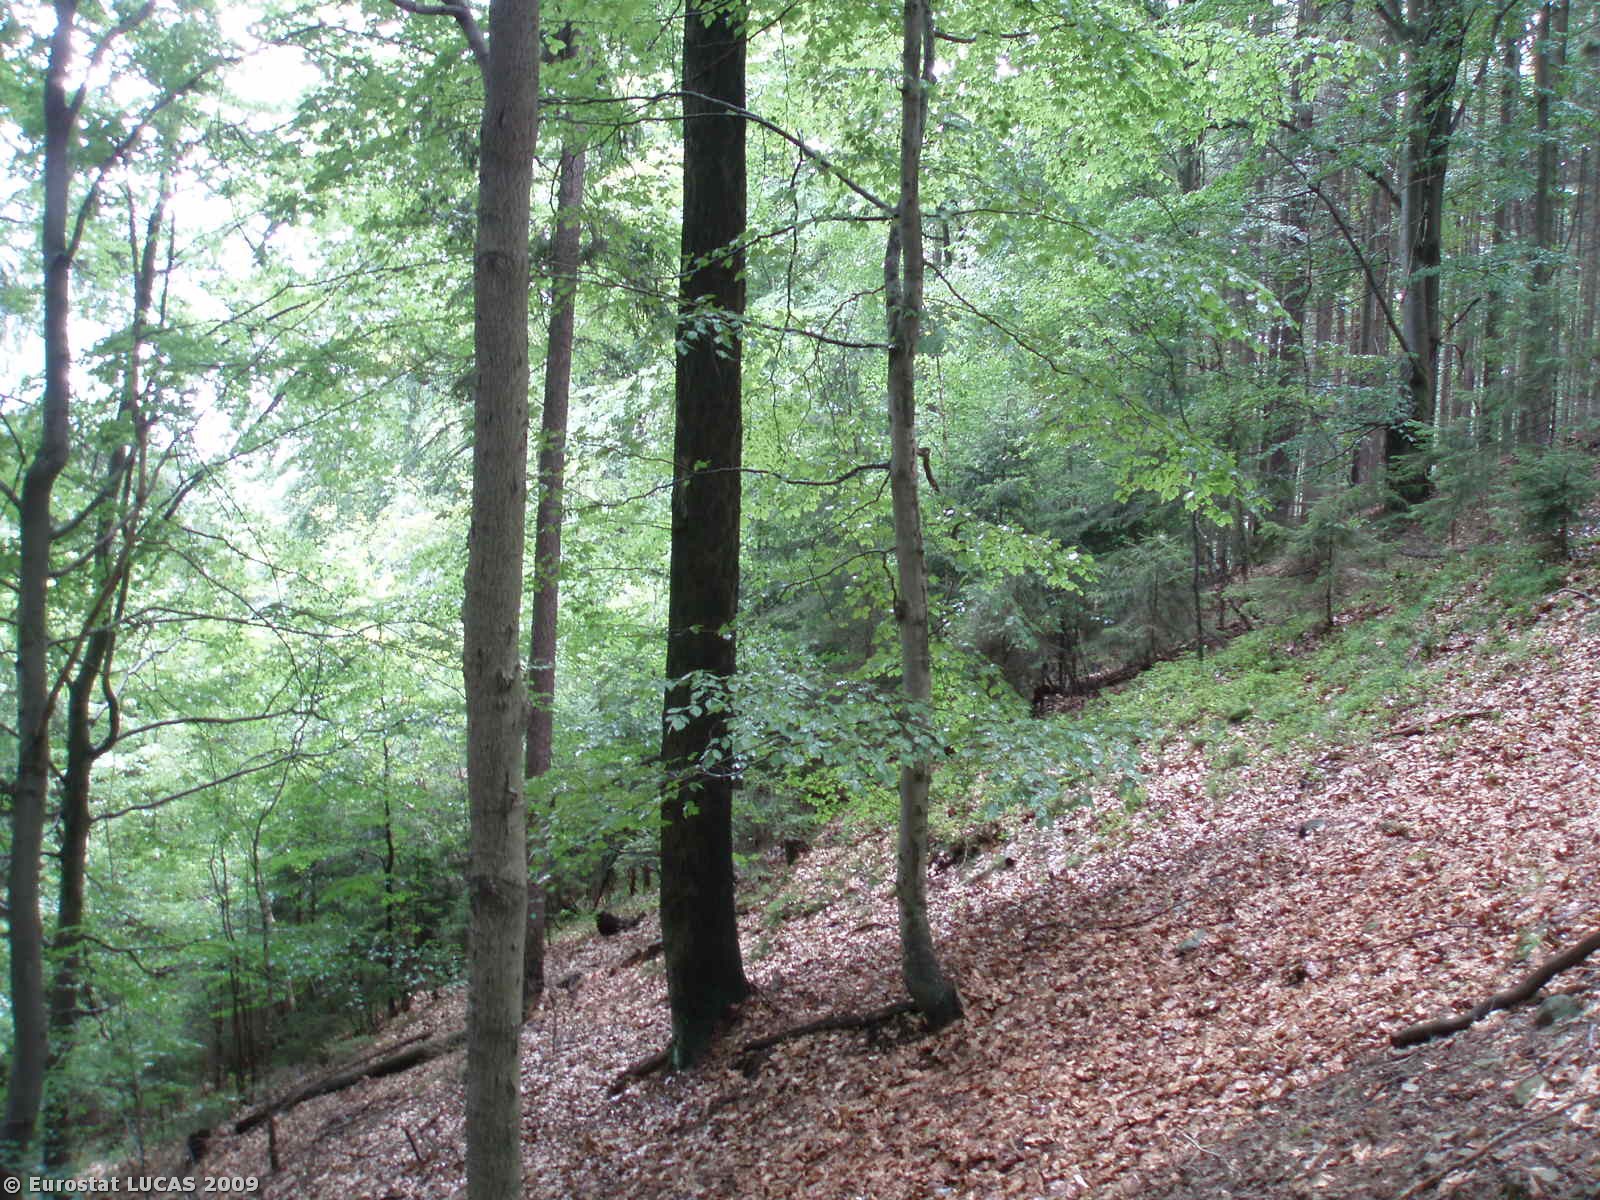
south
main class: Woodland
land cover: Broadleaved woodland
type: beech forest
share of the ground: > 75 %
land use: Forestry
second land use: Nature reserves
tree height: > 5 m
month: July
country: CZ
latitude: 50.8055
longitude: 14.7561
